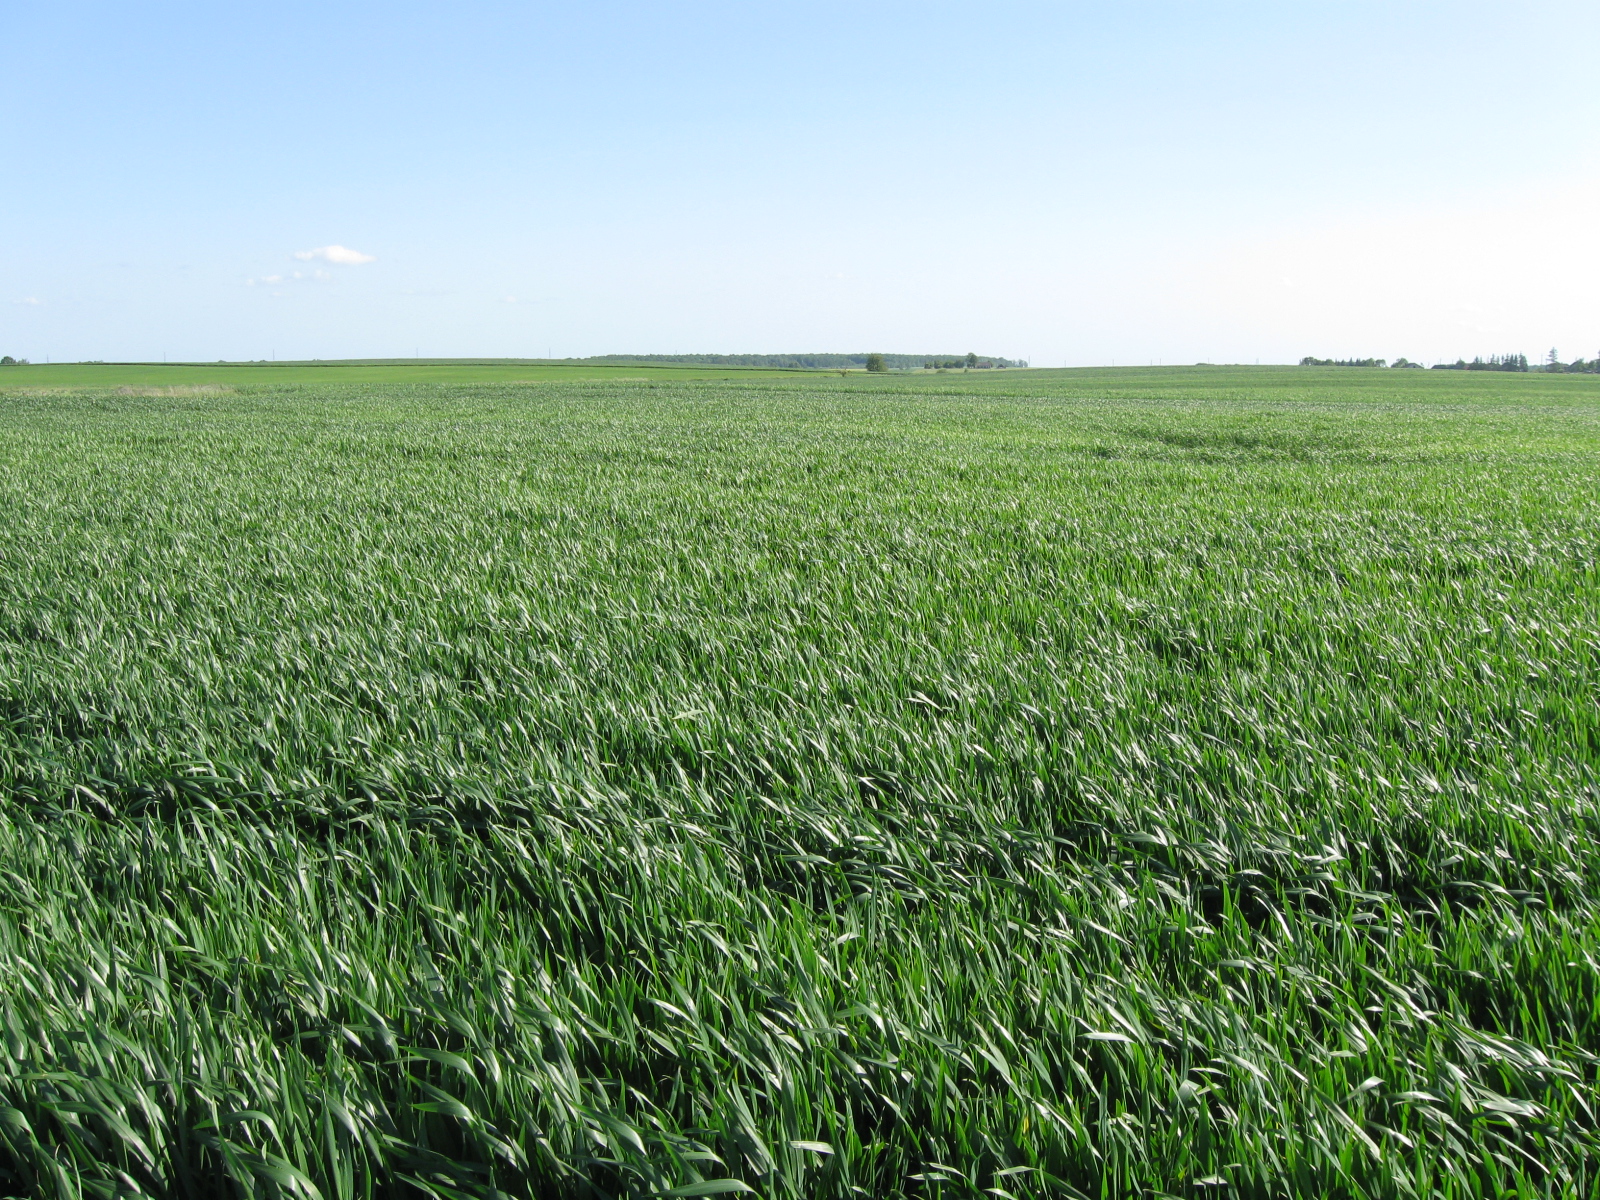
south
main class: Cropland
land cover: Common wheat
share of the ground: > 75 %
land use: Agriculture (excluding fallow land and kitchen gardens)
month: June
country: LT
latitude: 54.4577
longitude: 23.7383
